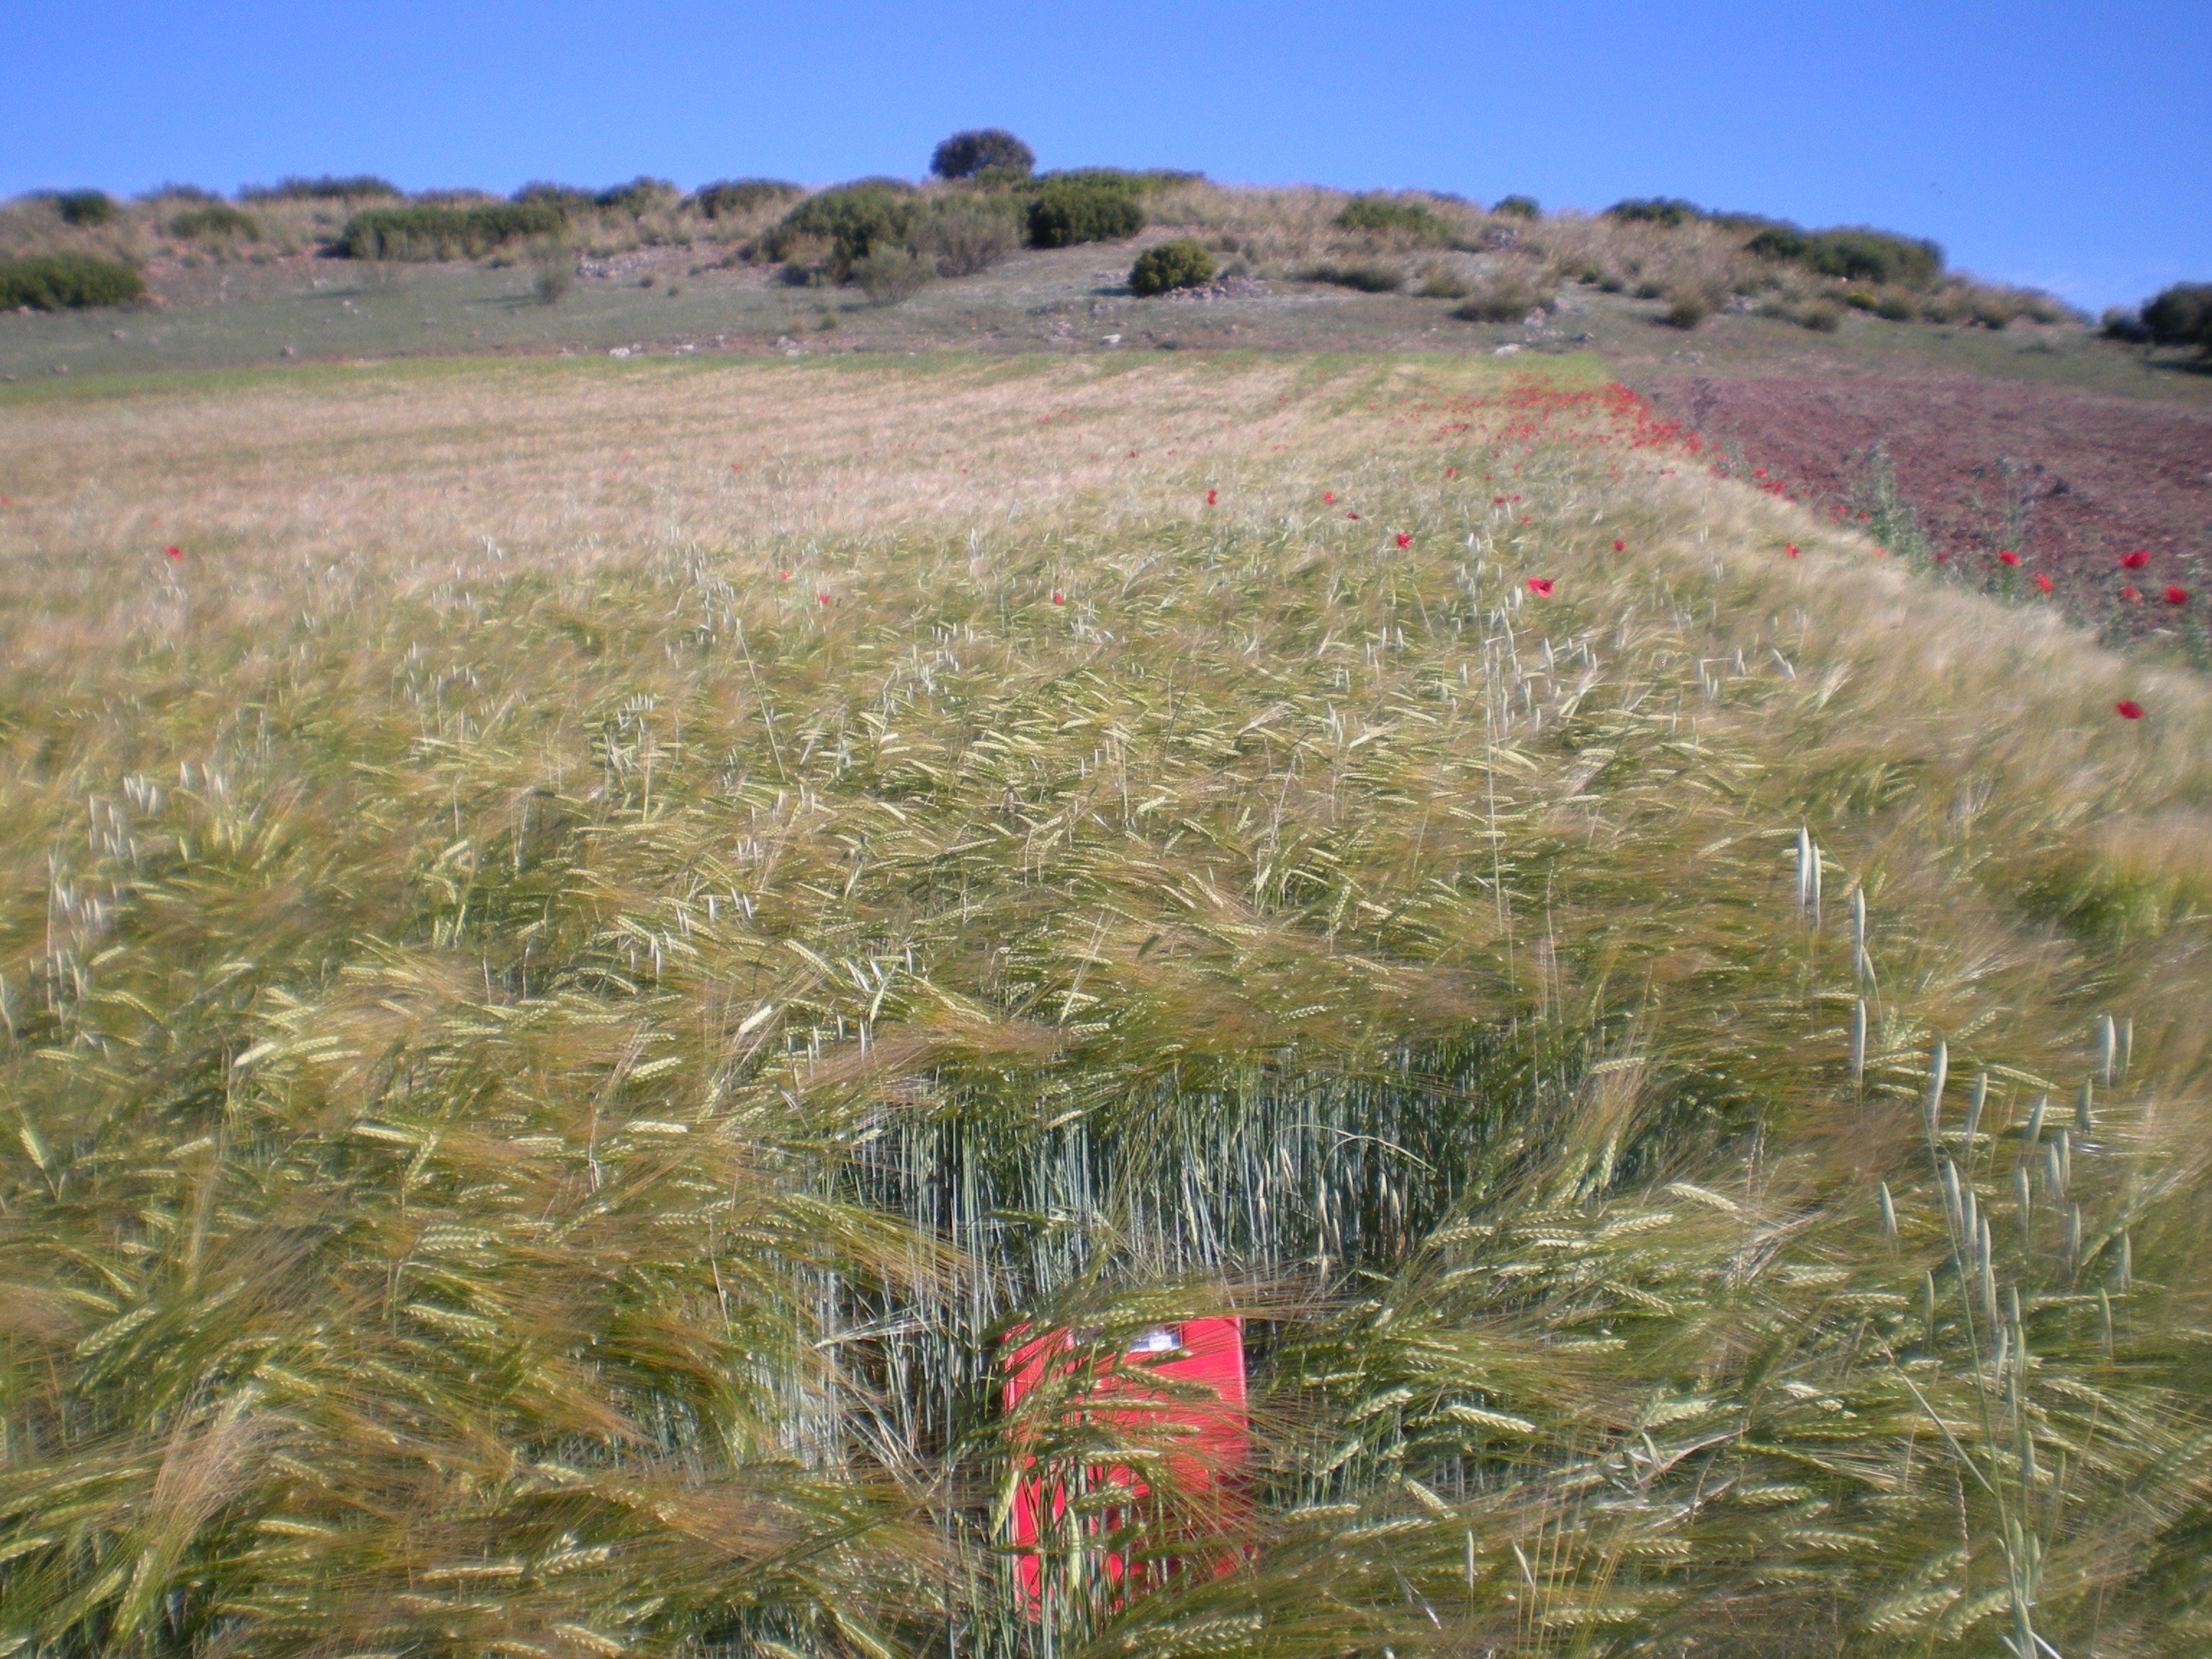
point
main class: Cropland
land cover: Barley
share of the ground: > 75 %
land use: Agriculture (excluding fallow land and kitchen gardens)
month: May
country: ES
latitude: 38.9298
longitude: -3.0797
